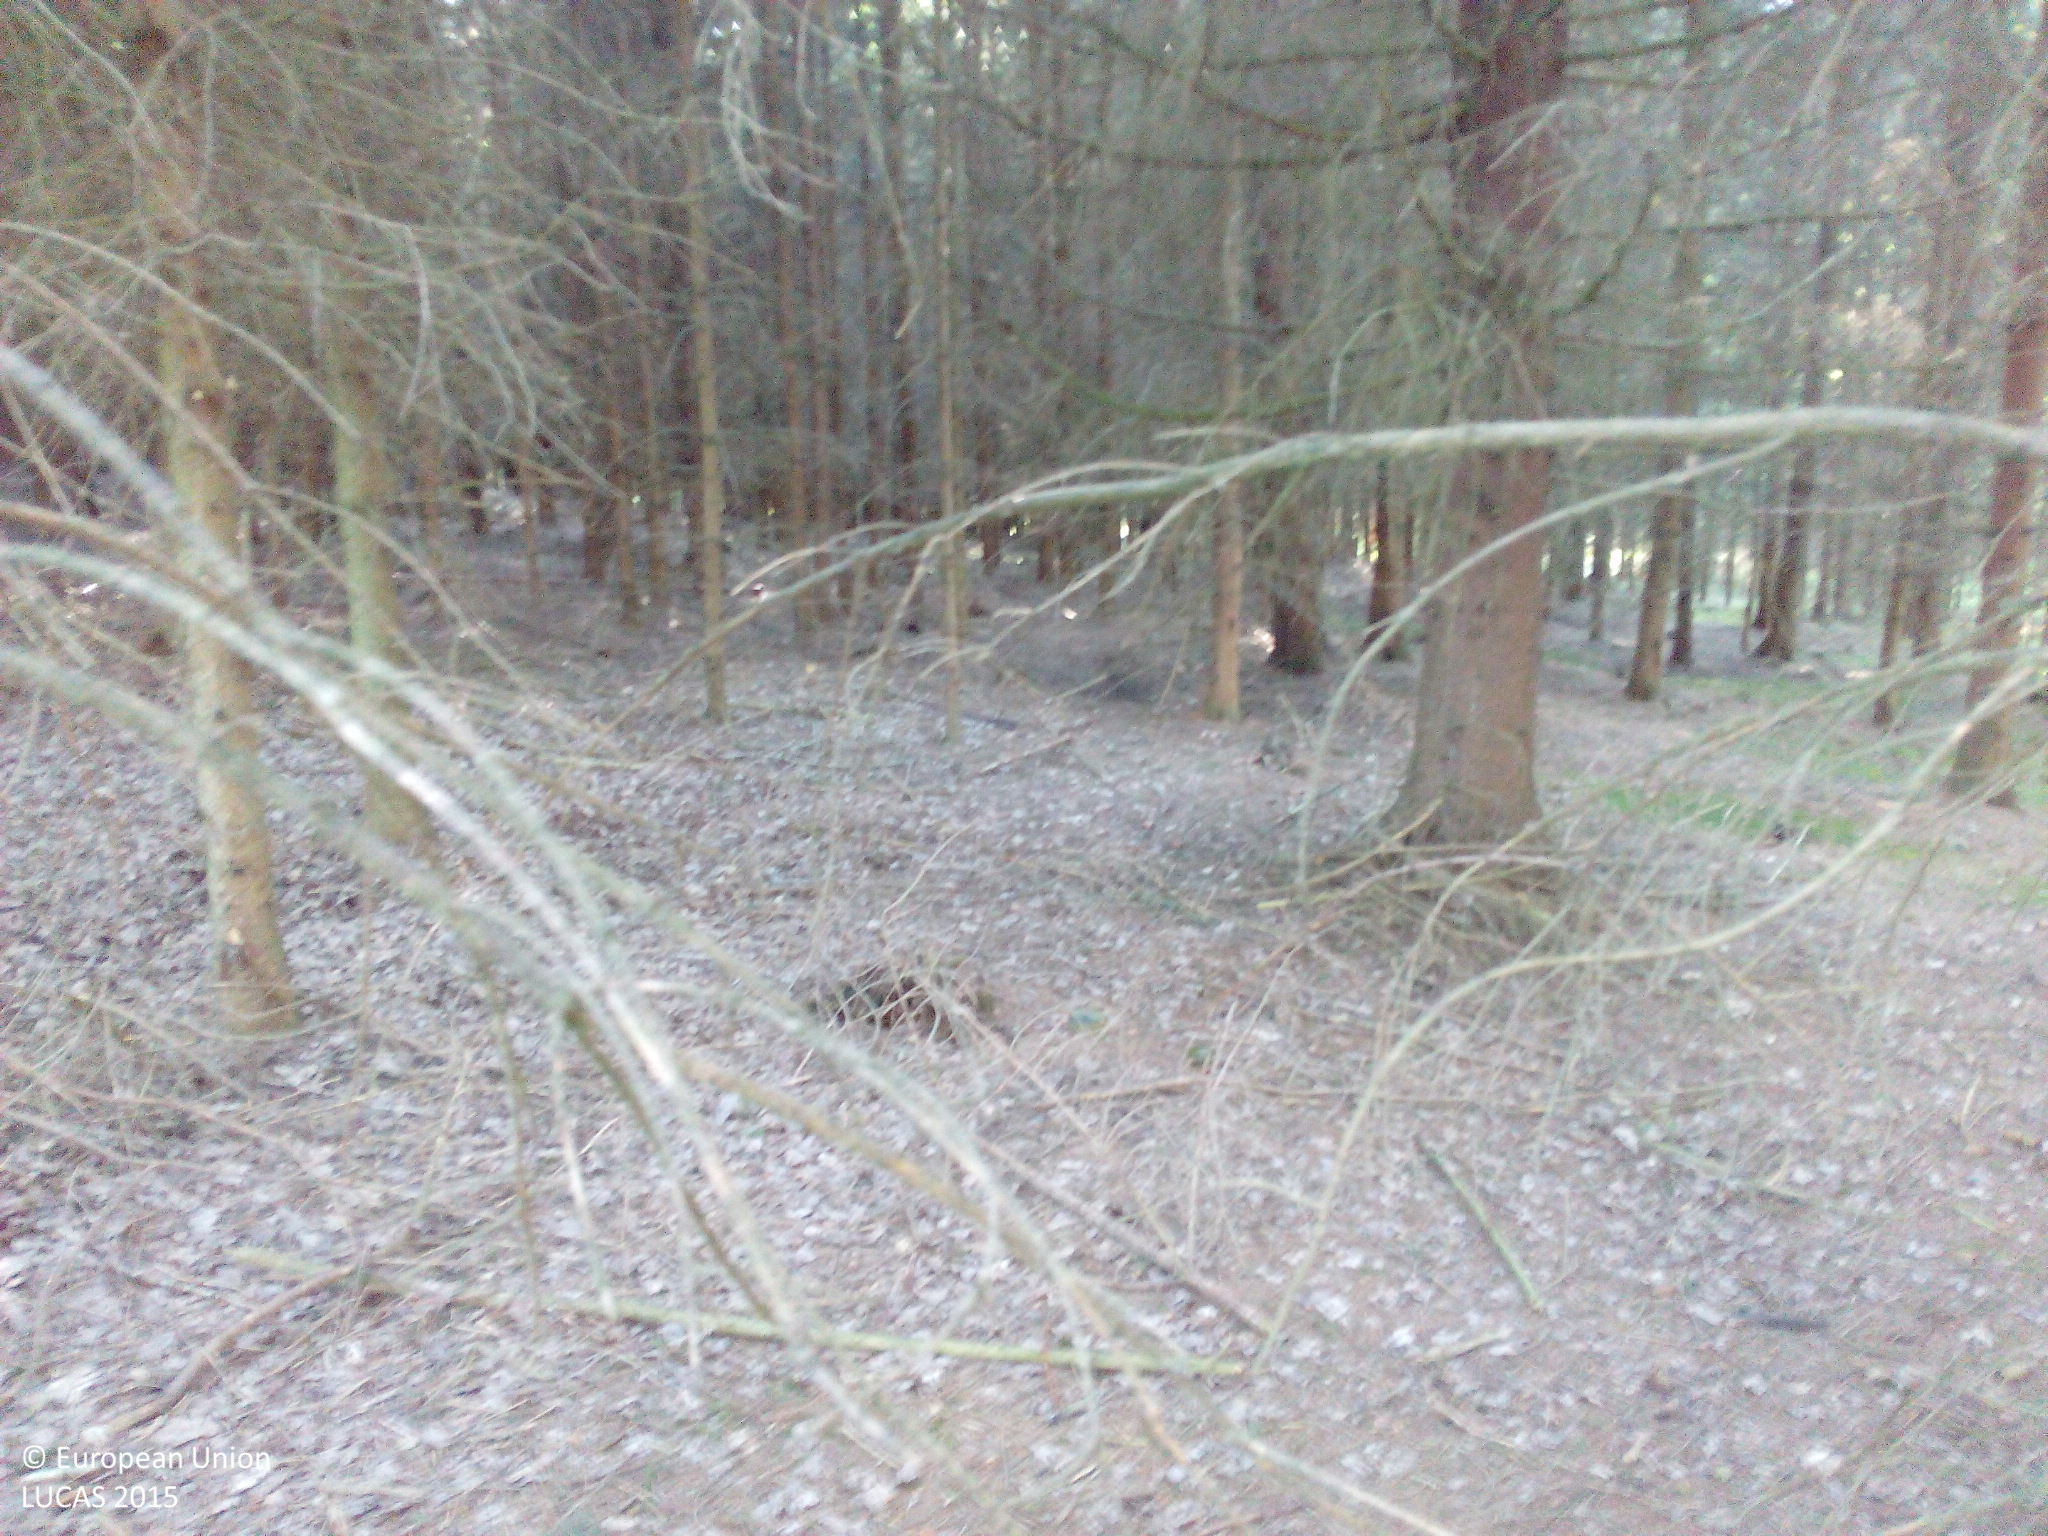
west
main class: Woodland
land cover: Spruce dominated coniferous woodland
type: hemiboreal forest and nemoral coniferous forest and mixed broadleaved-coniferous forest
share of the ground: > 75 %
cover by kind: coniferous forest trees 95 %, unconsolidated bare surface 5 %
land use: Forestry
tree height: > 5 m
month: May
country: DE
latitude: 48.3636
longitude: 12.1992
